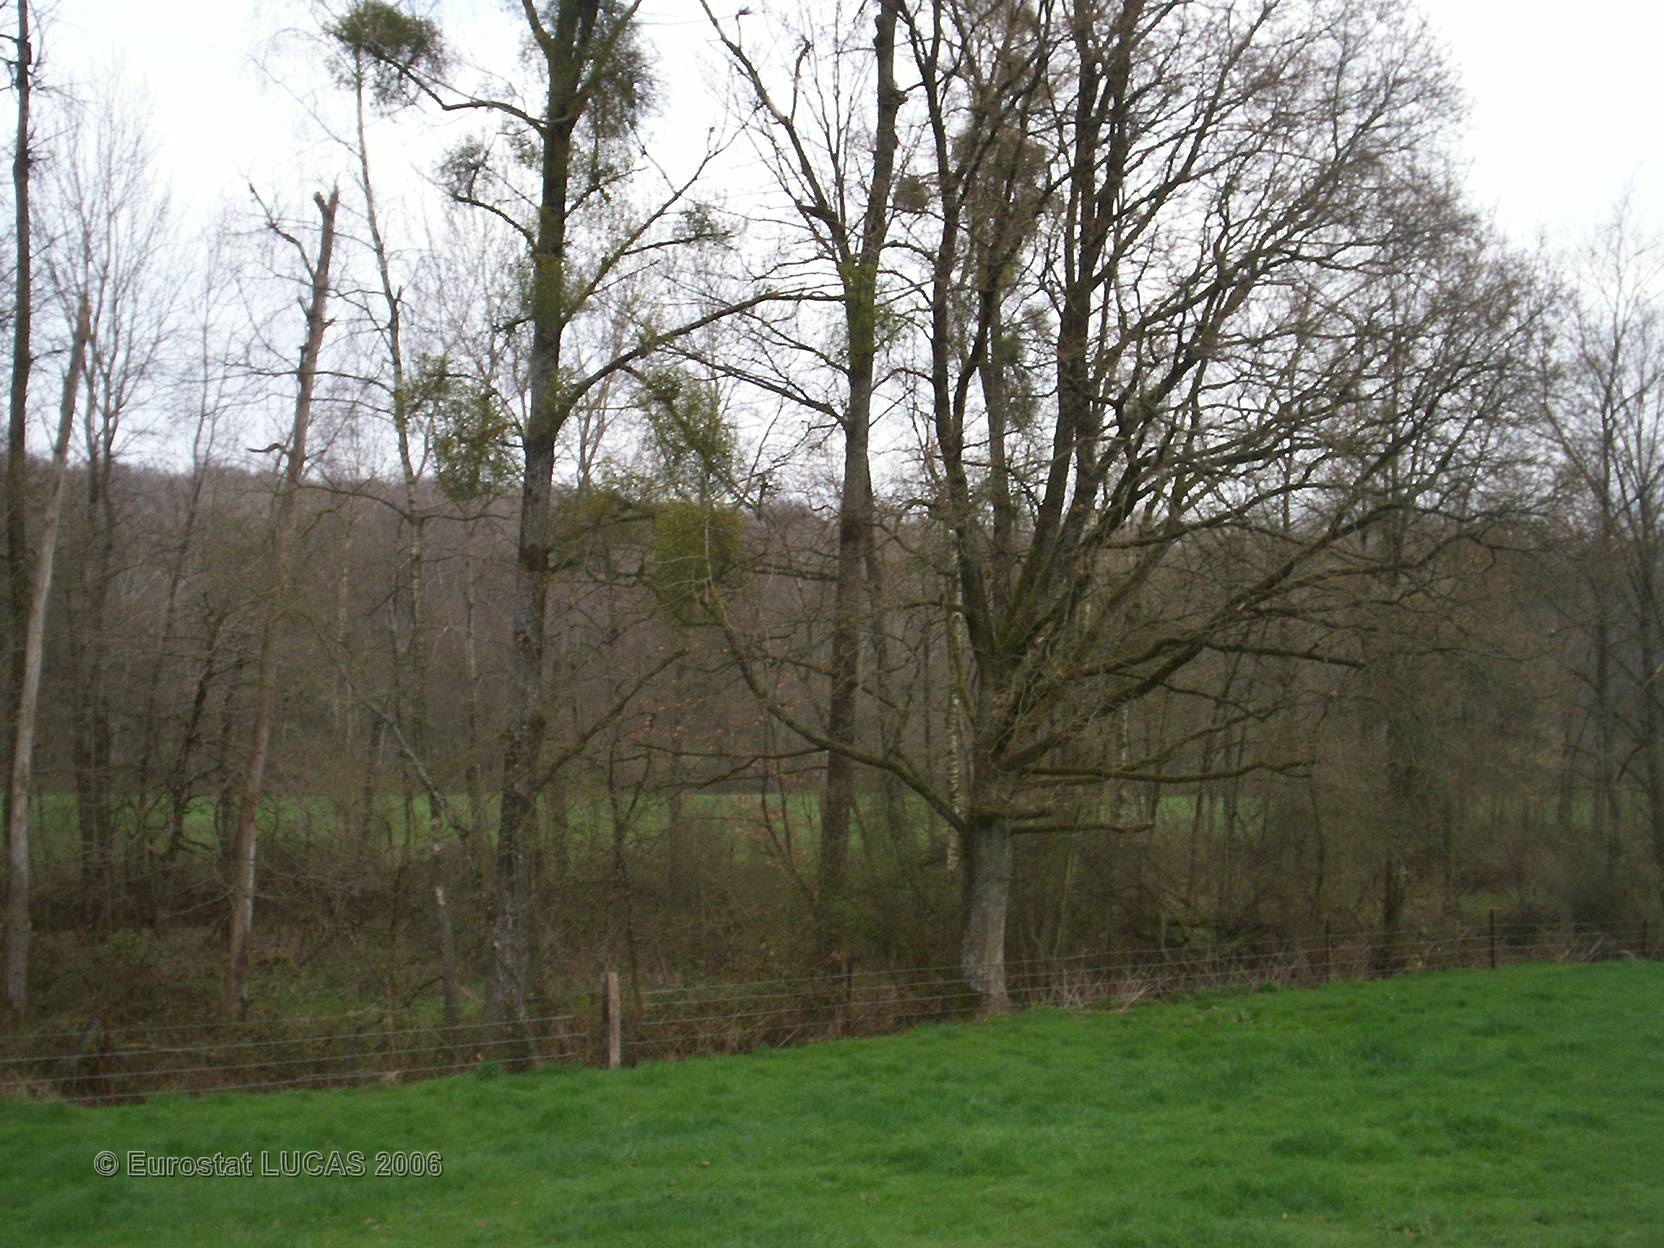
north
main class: Grassland
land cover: Grassland without tree/shrub cover
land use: Agriculture (excluding fallow land and kitchen gardens)
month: April
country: FR
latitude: 49.4361
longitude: 4.8259
